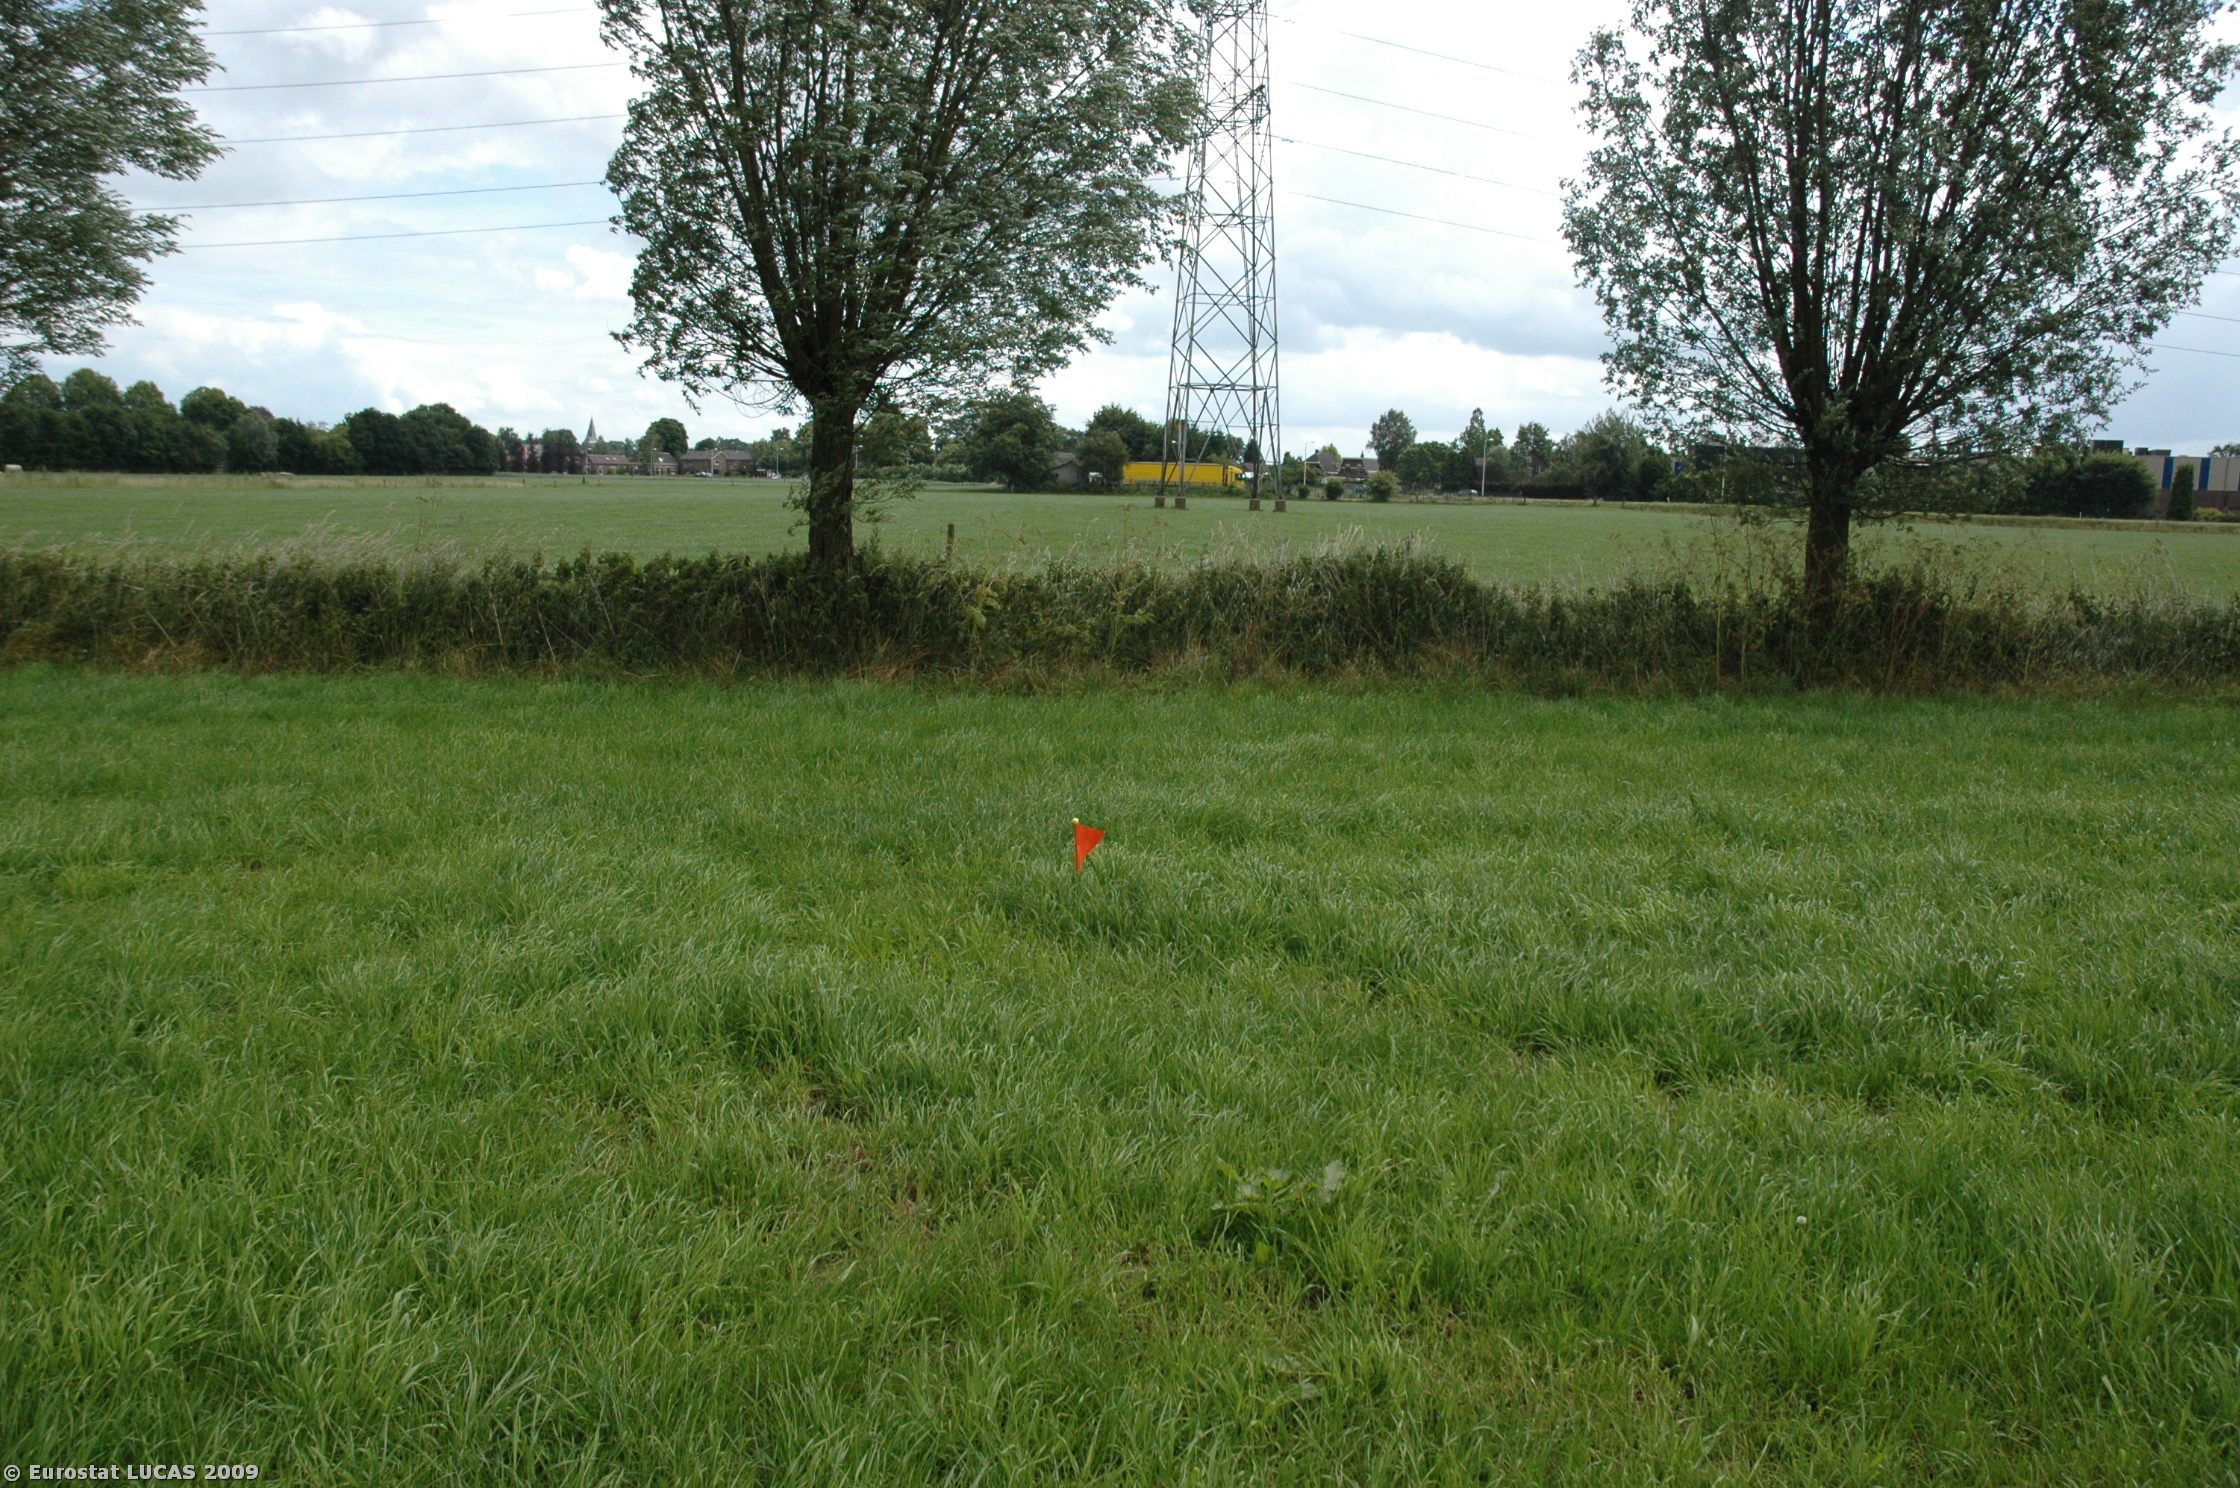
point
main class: Grassland
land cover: Grassland without tree/shrub cover
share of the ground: > 75 %
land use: Agriculture (excluding fallow land and kitchen gardens)
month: June
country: NL
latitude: 52.2411
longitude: 6.0891
